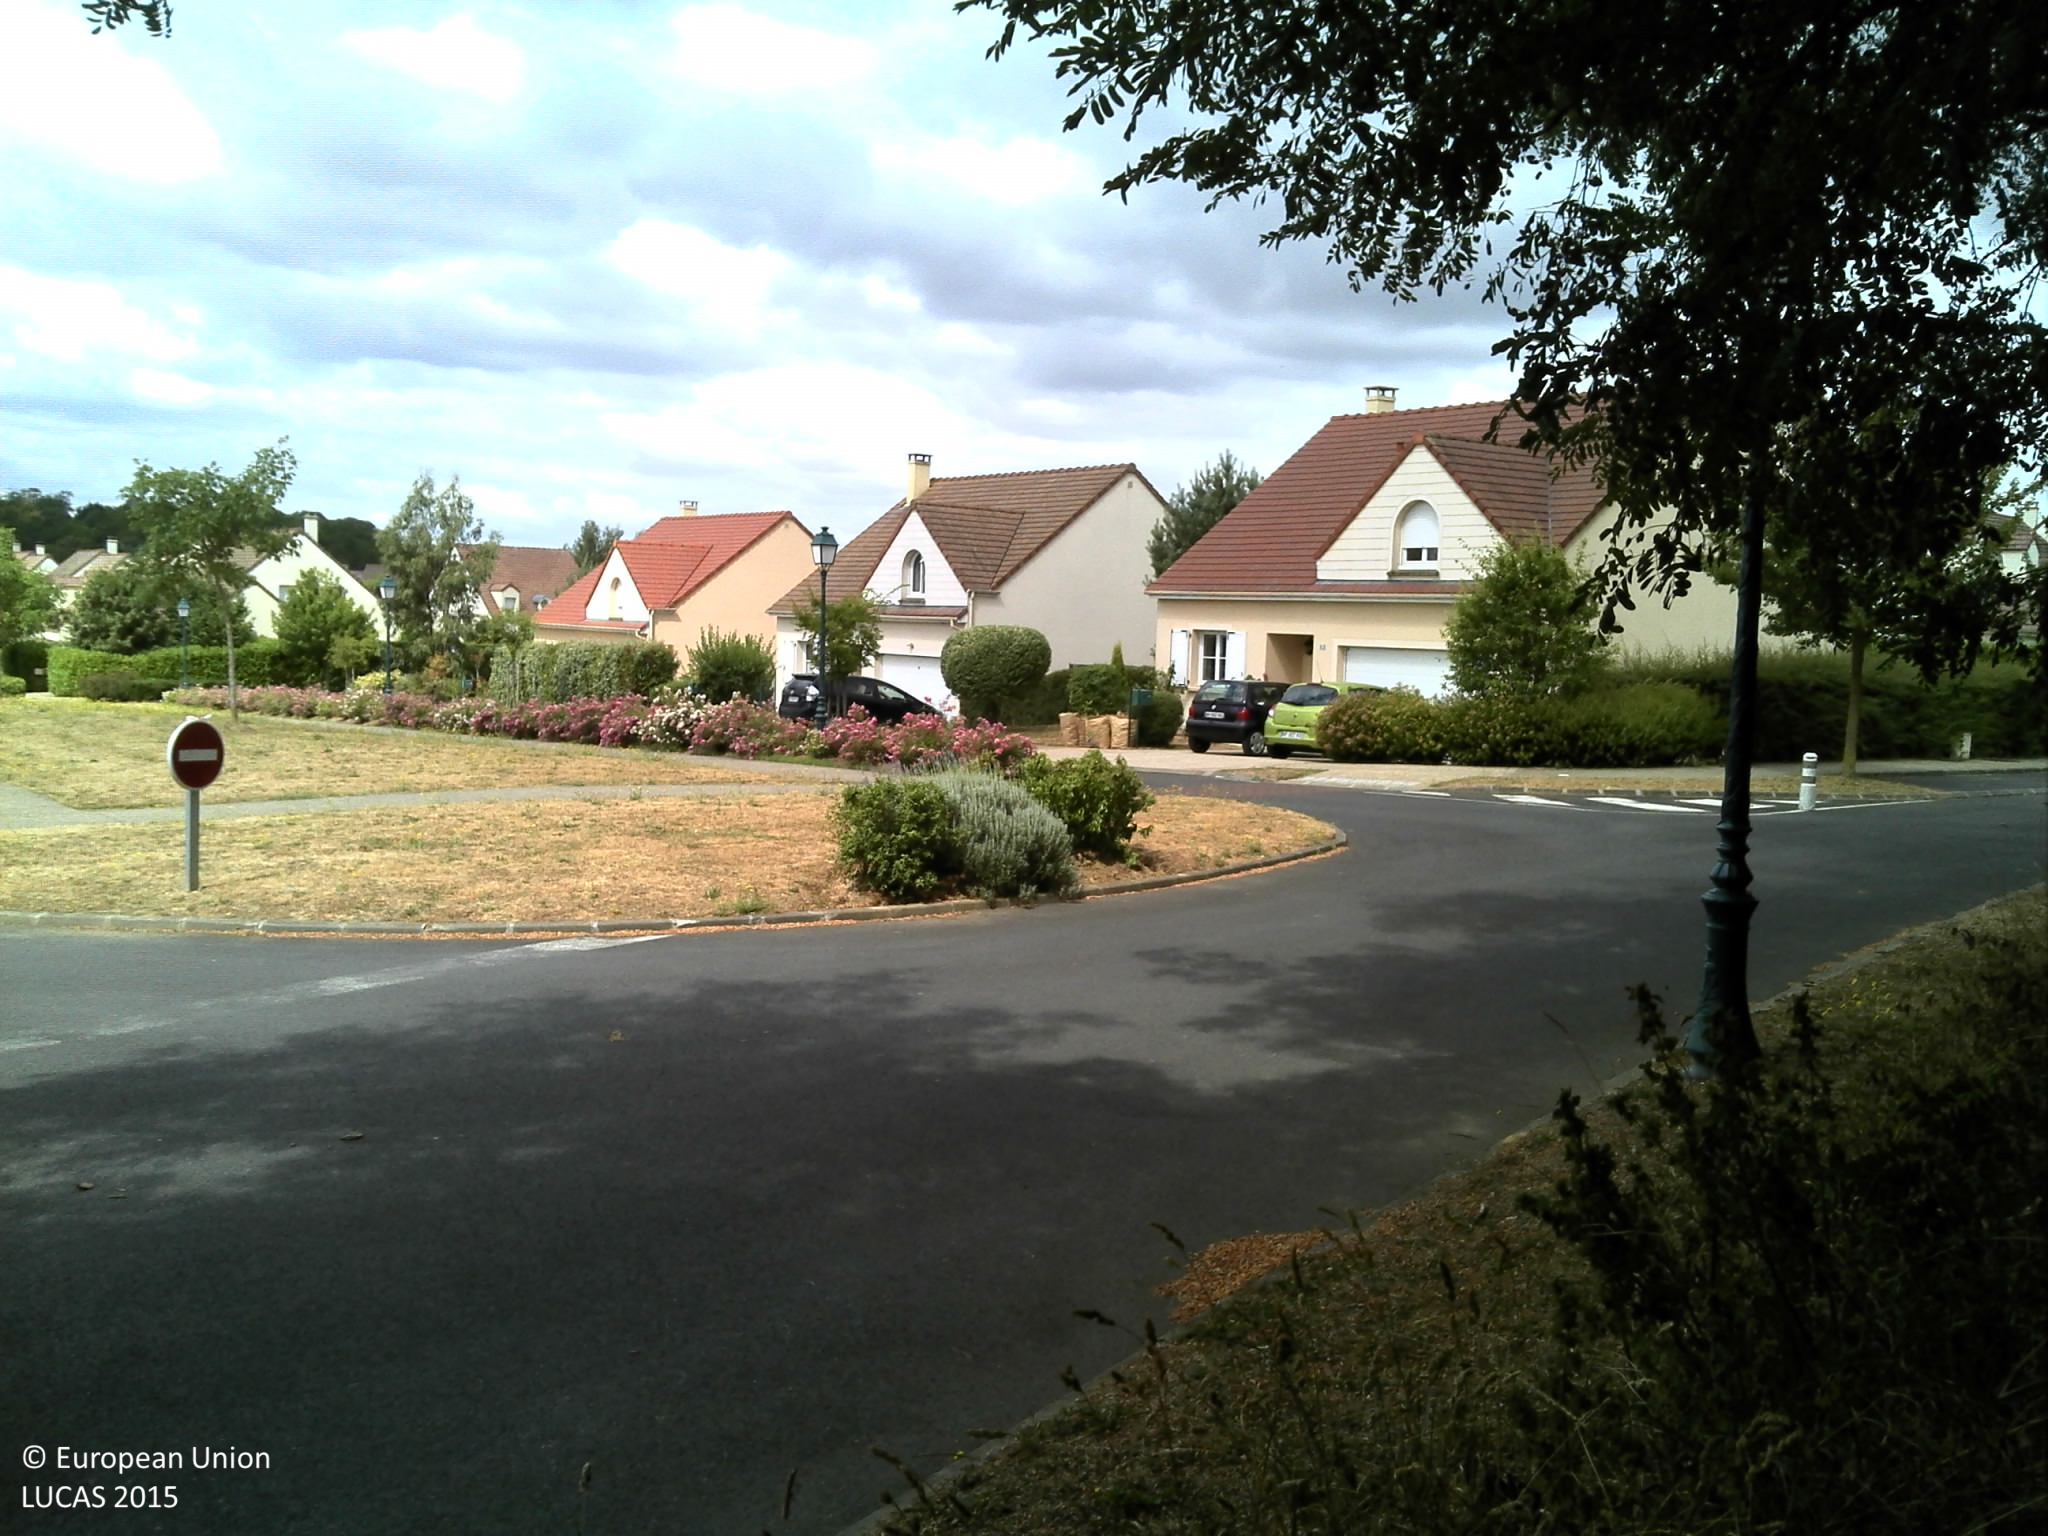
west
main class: Woodland
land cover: Broadleaved woodland
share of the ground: 25 - 50 %
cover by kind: broadleaved forest trees 80 %, herbaceous plants 20 %
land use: Agriculture (excluding fallow land and kitchen gardens)
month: July
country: FR
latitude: 48.5602
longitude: 2.4417
